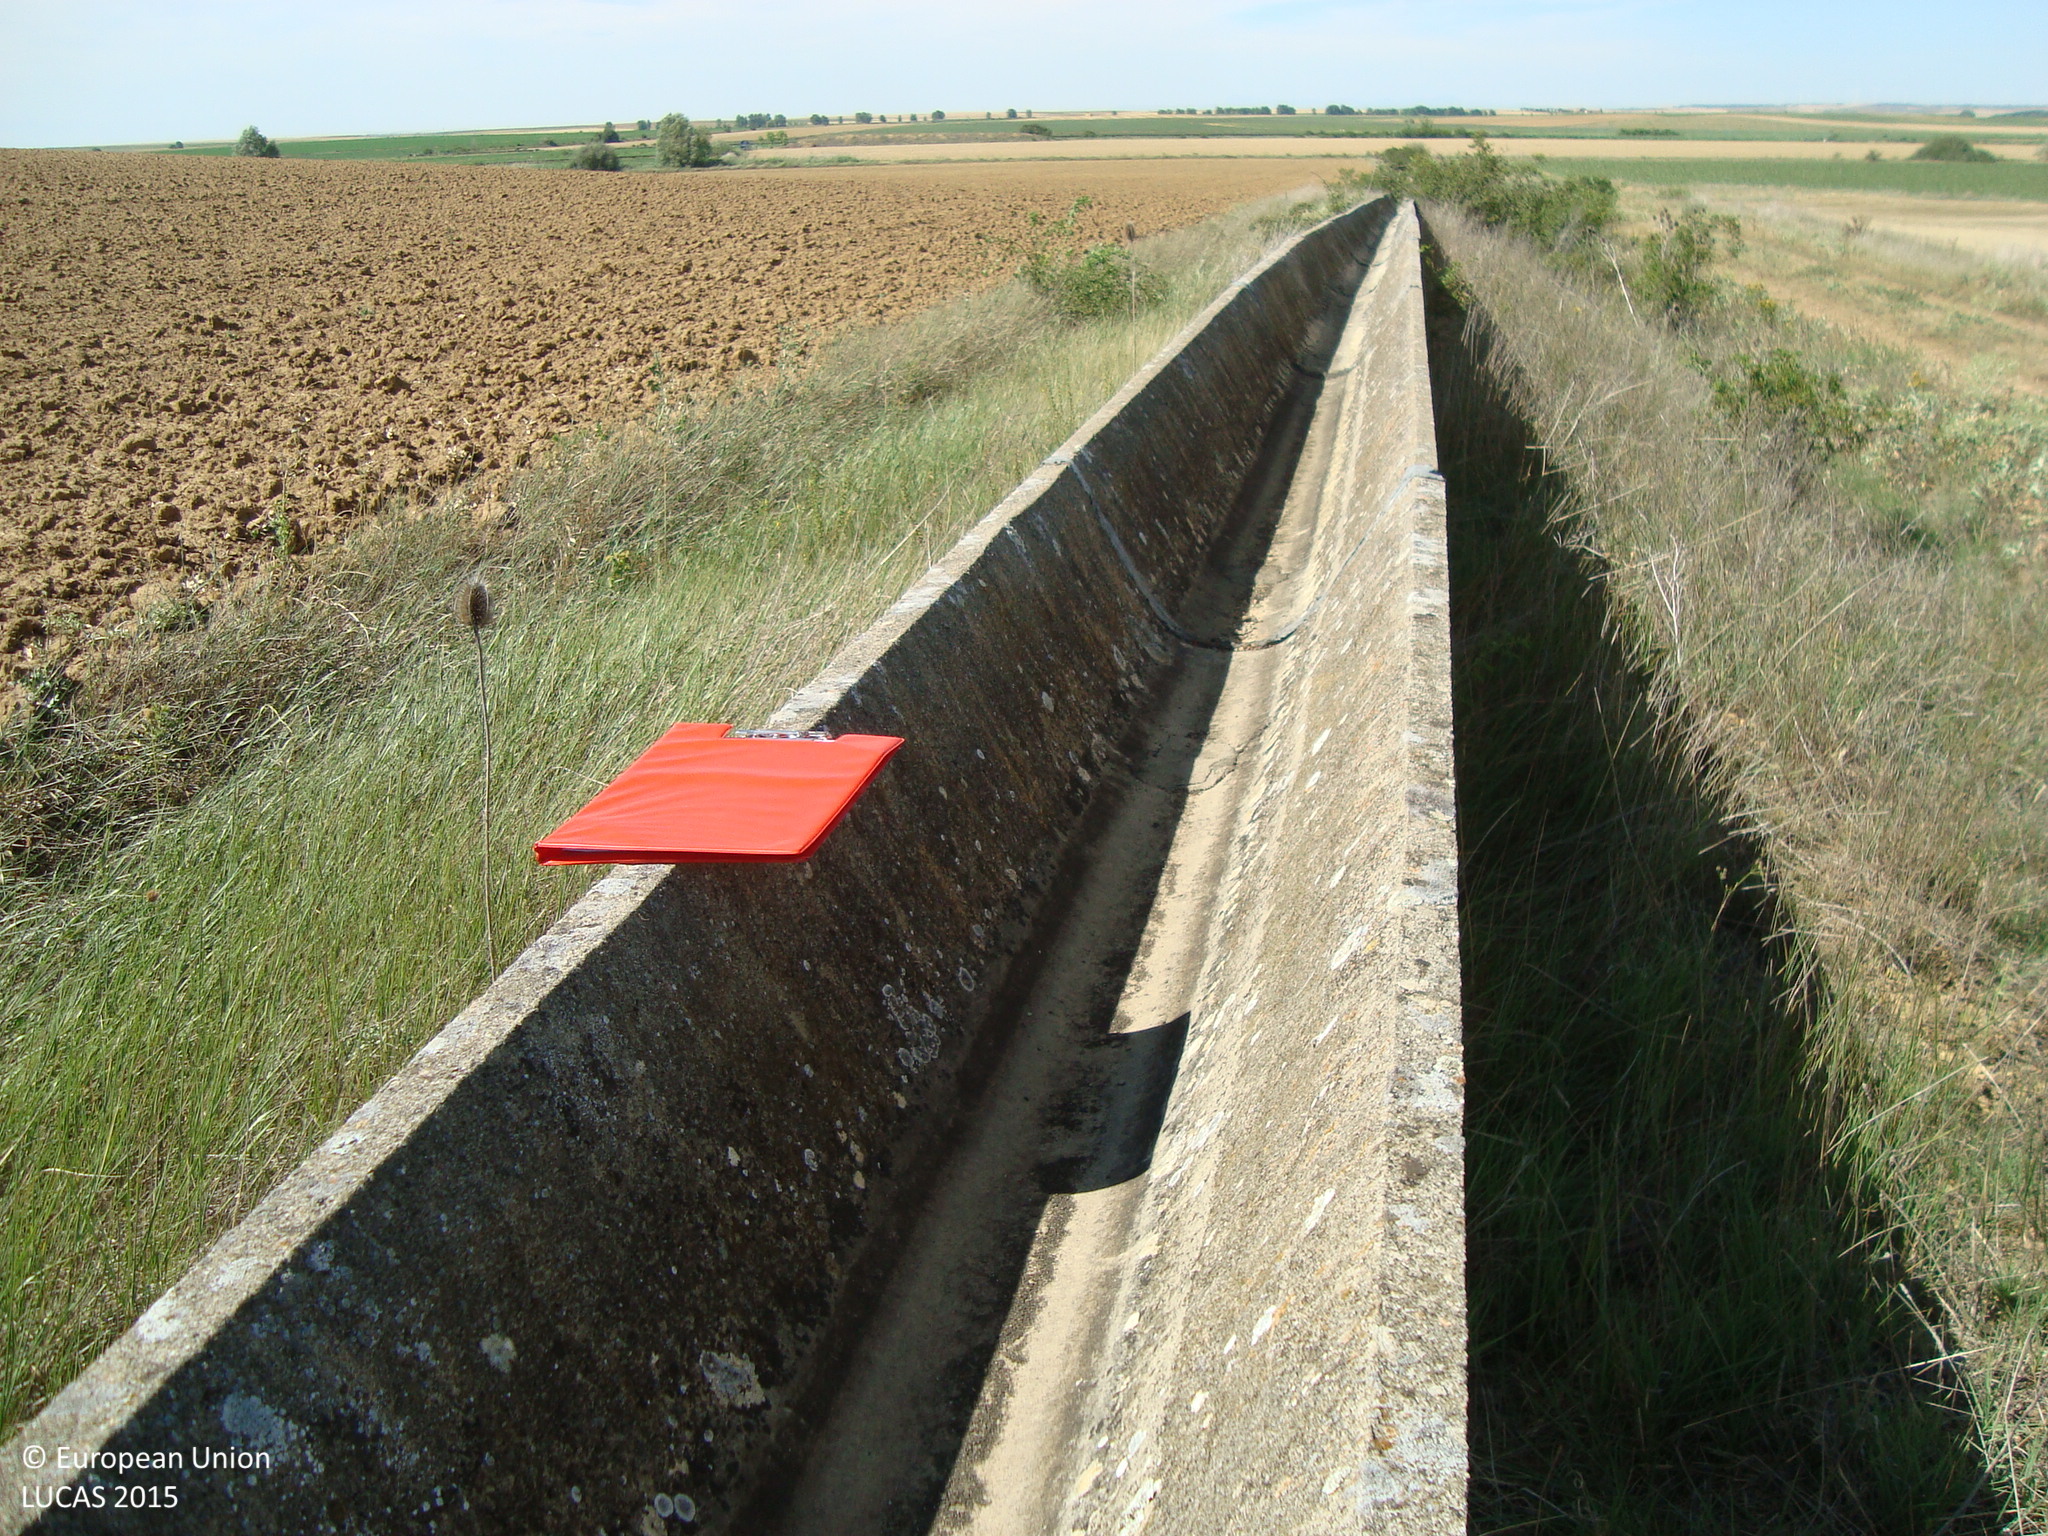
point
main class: Cropland
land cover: Barley
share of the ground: < 10 %
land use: Agriculture (excluding fallow land and kitchen gardens)
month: July
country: ES
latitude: 42.1142
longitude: -4.7704
